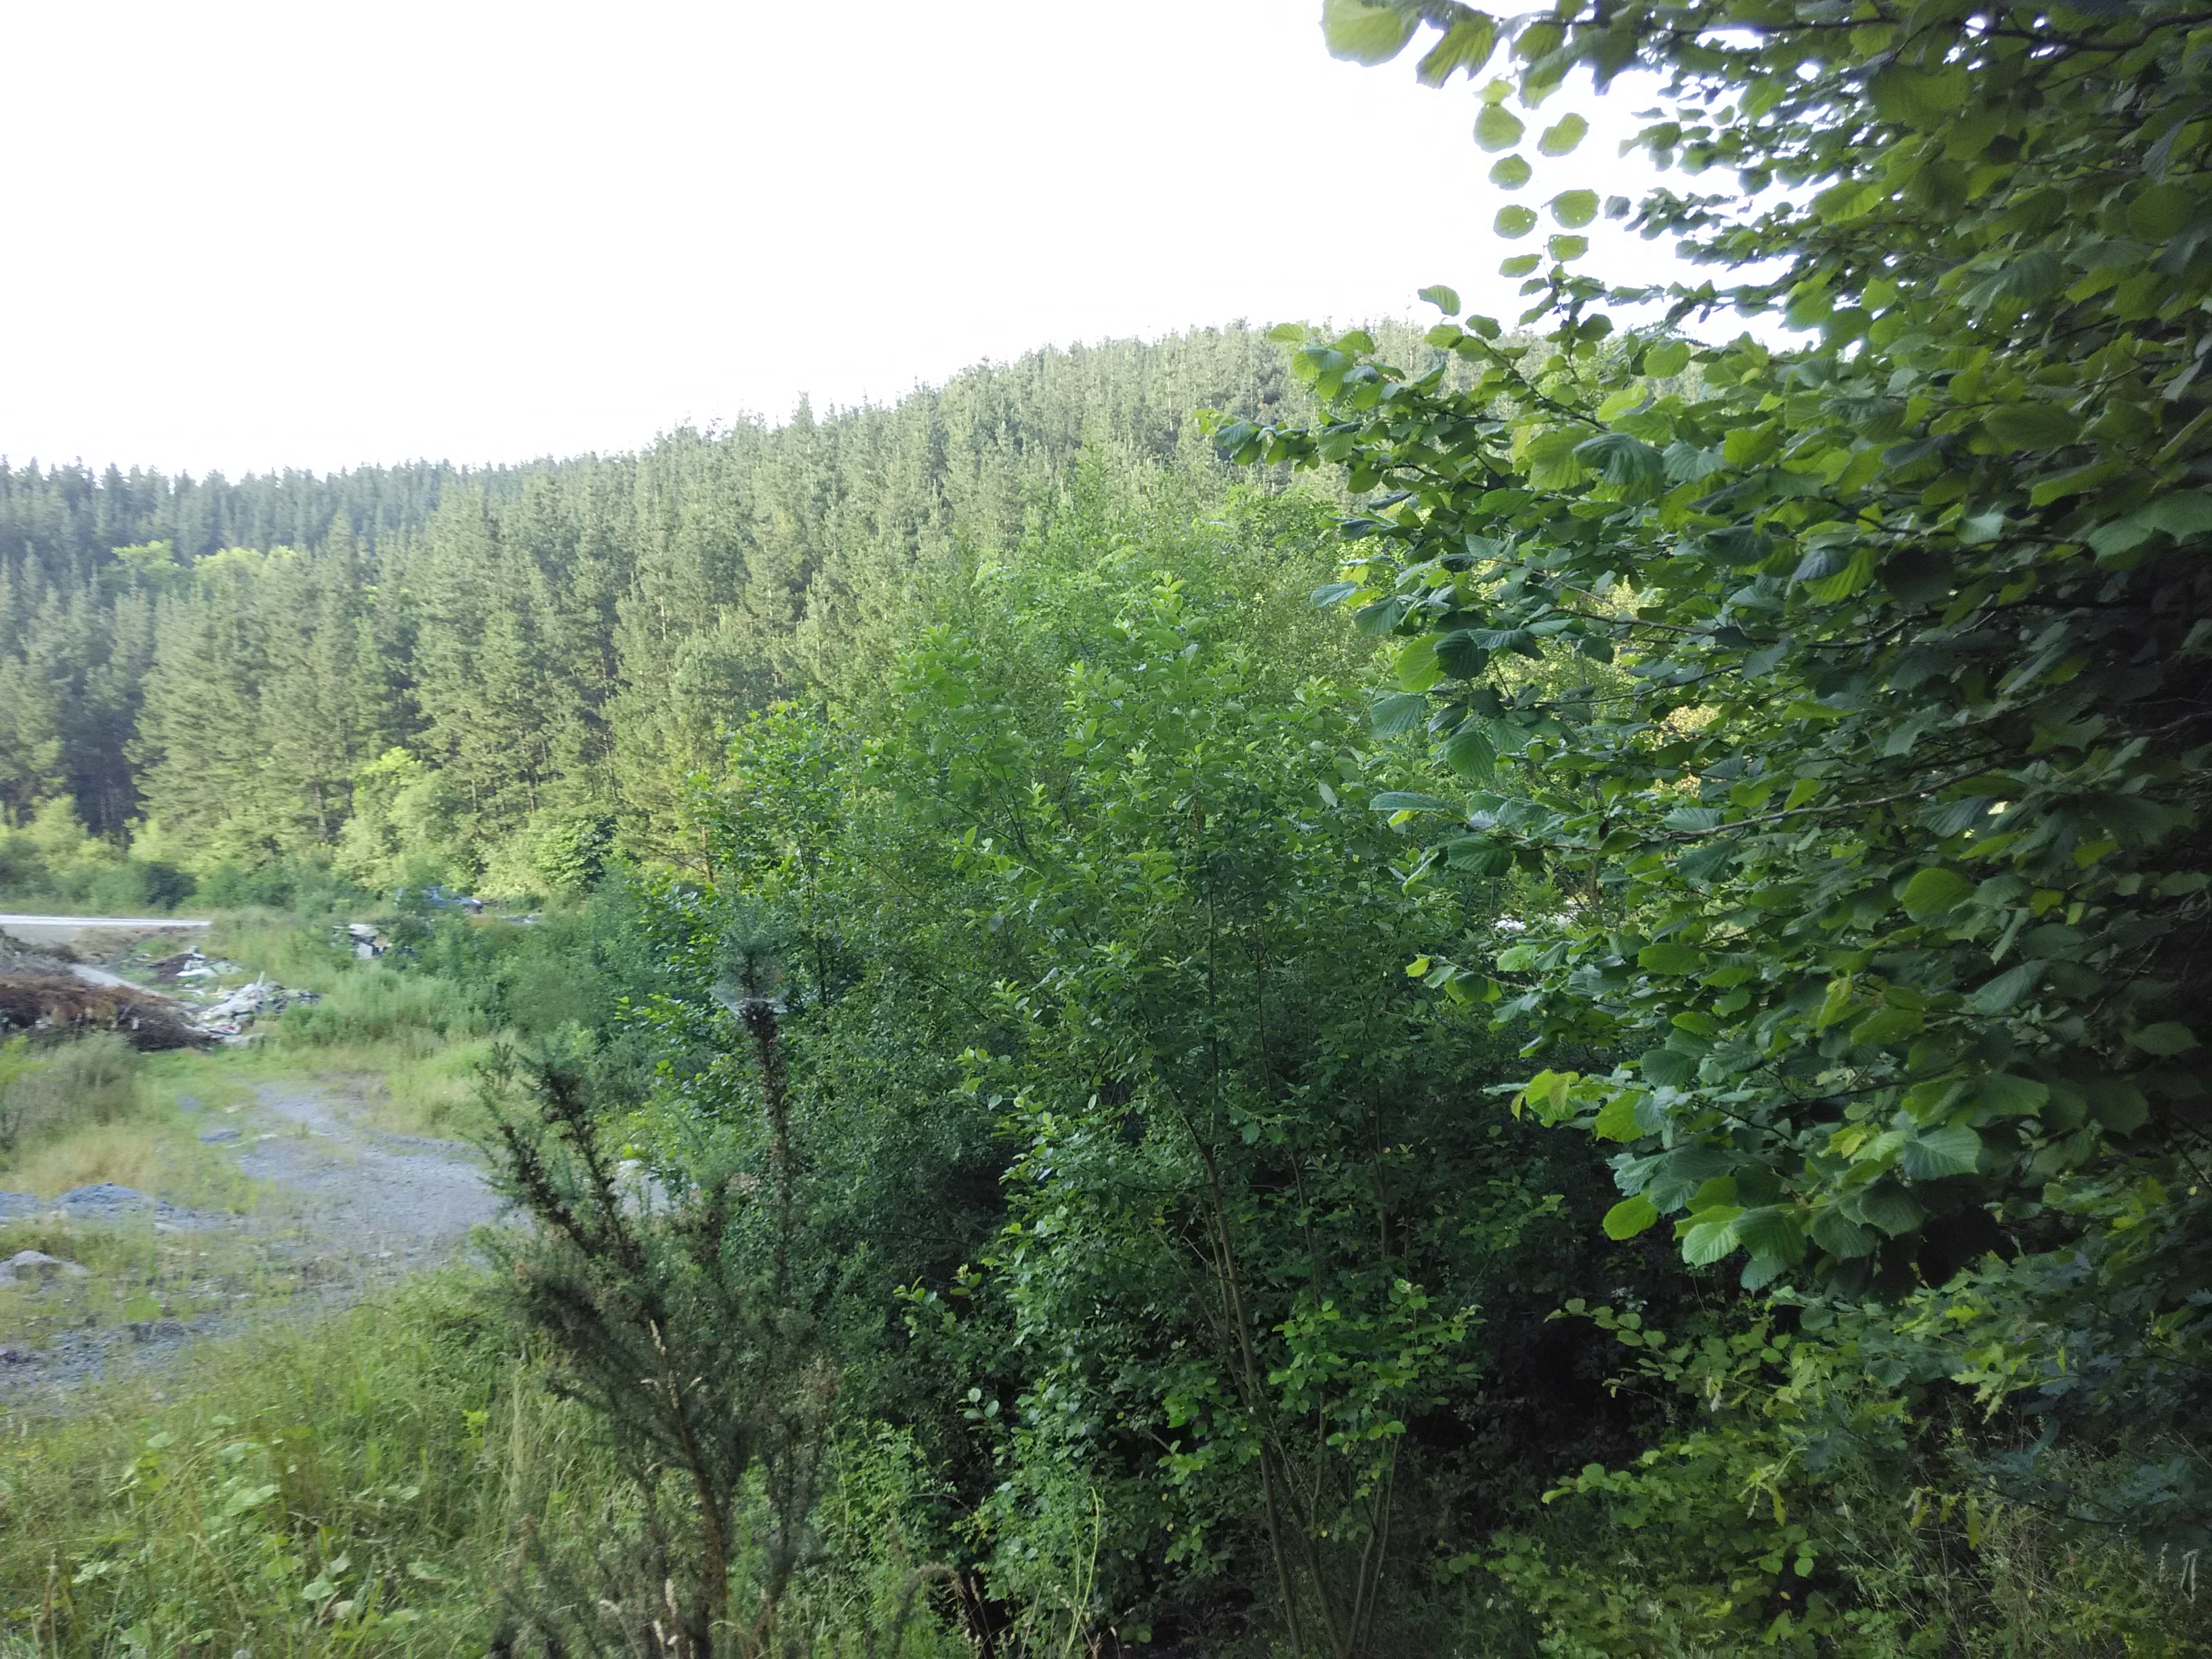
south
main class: Woodland
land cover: Broadleaved woodland
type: acidophilous oak and oak-birch forest
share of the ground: > 75 %
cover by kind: broadleaved forest trees 100 %
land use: Forestry
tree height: > 5 m
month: July
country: ES
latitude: 43.0697
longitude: -2.2924
